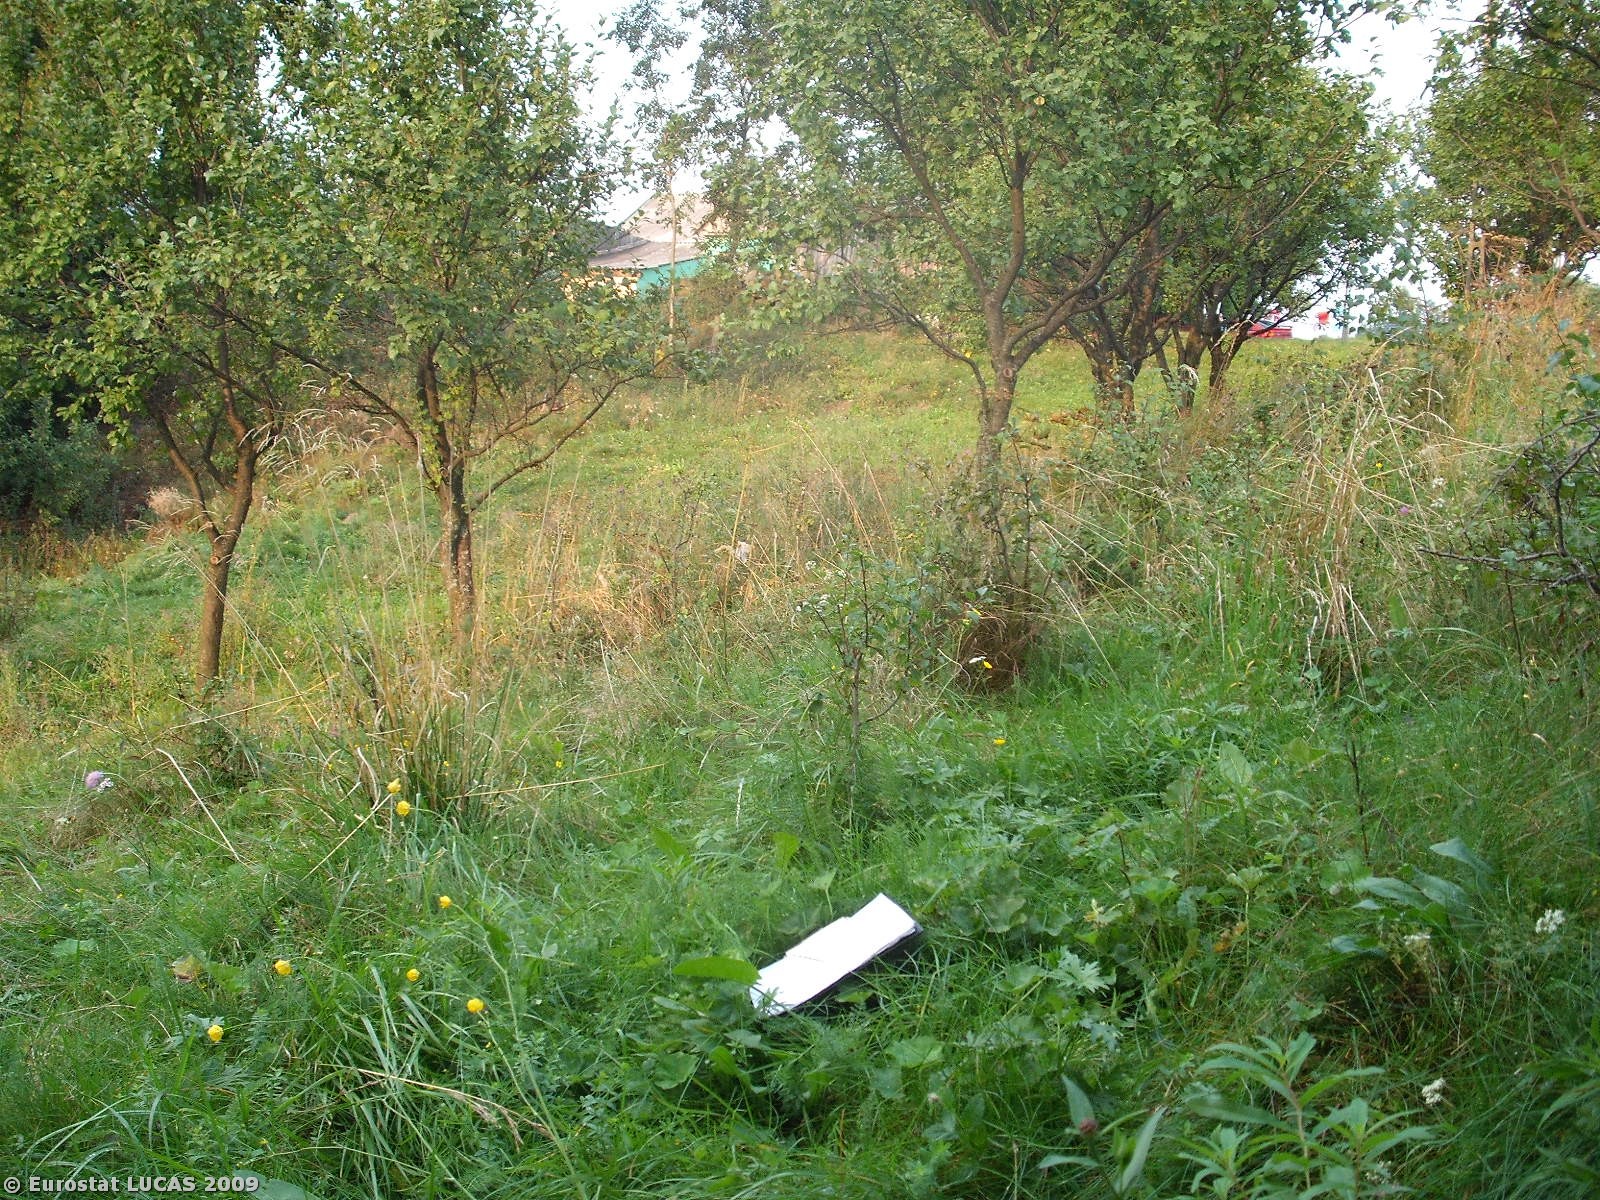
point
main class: Grassland
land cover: Grassland with sparse tree/shrub cover
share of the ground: > 75 %
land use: Agriculture (excluding fallow land and kitchen gardens)
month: September
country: PL
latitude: 49.6290
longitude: 20.4616
